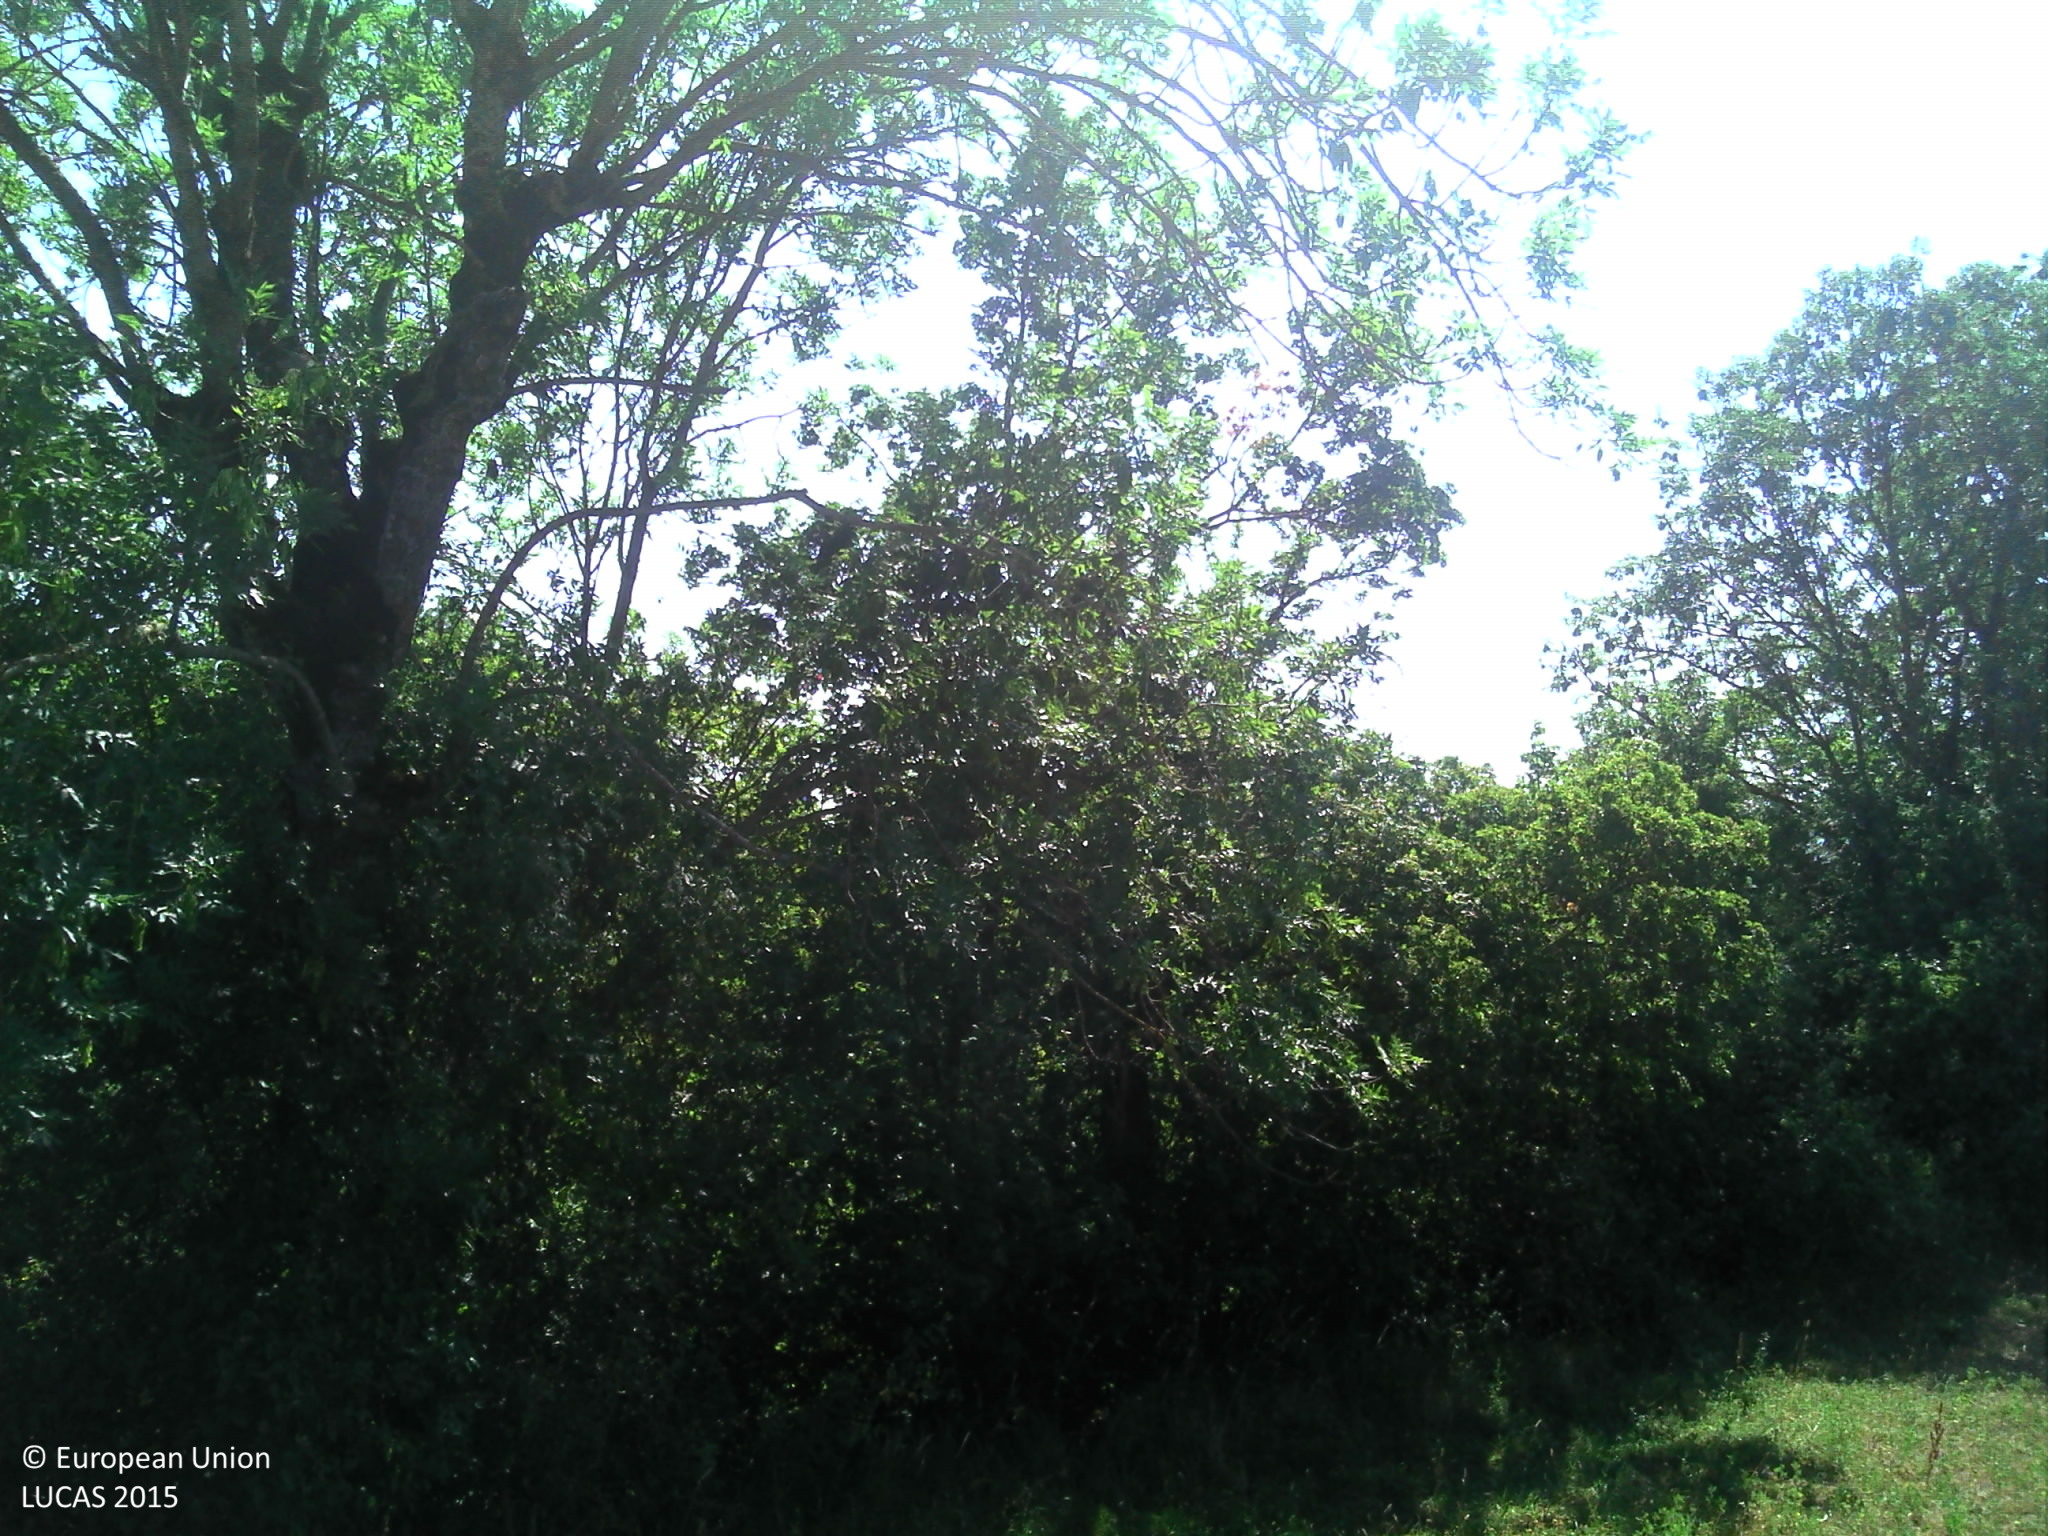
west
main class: Cropland
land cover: Temporary grasslands
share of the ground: > 75 %
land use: Agriculture (excluding fallow land and kitchen gardens)
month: July
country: FR
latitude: 44.5318
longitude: 3.2975
